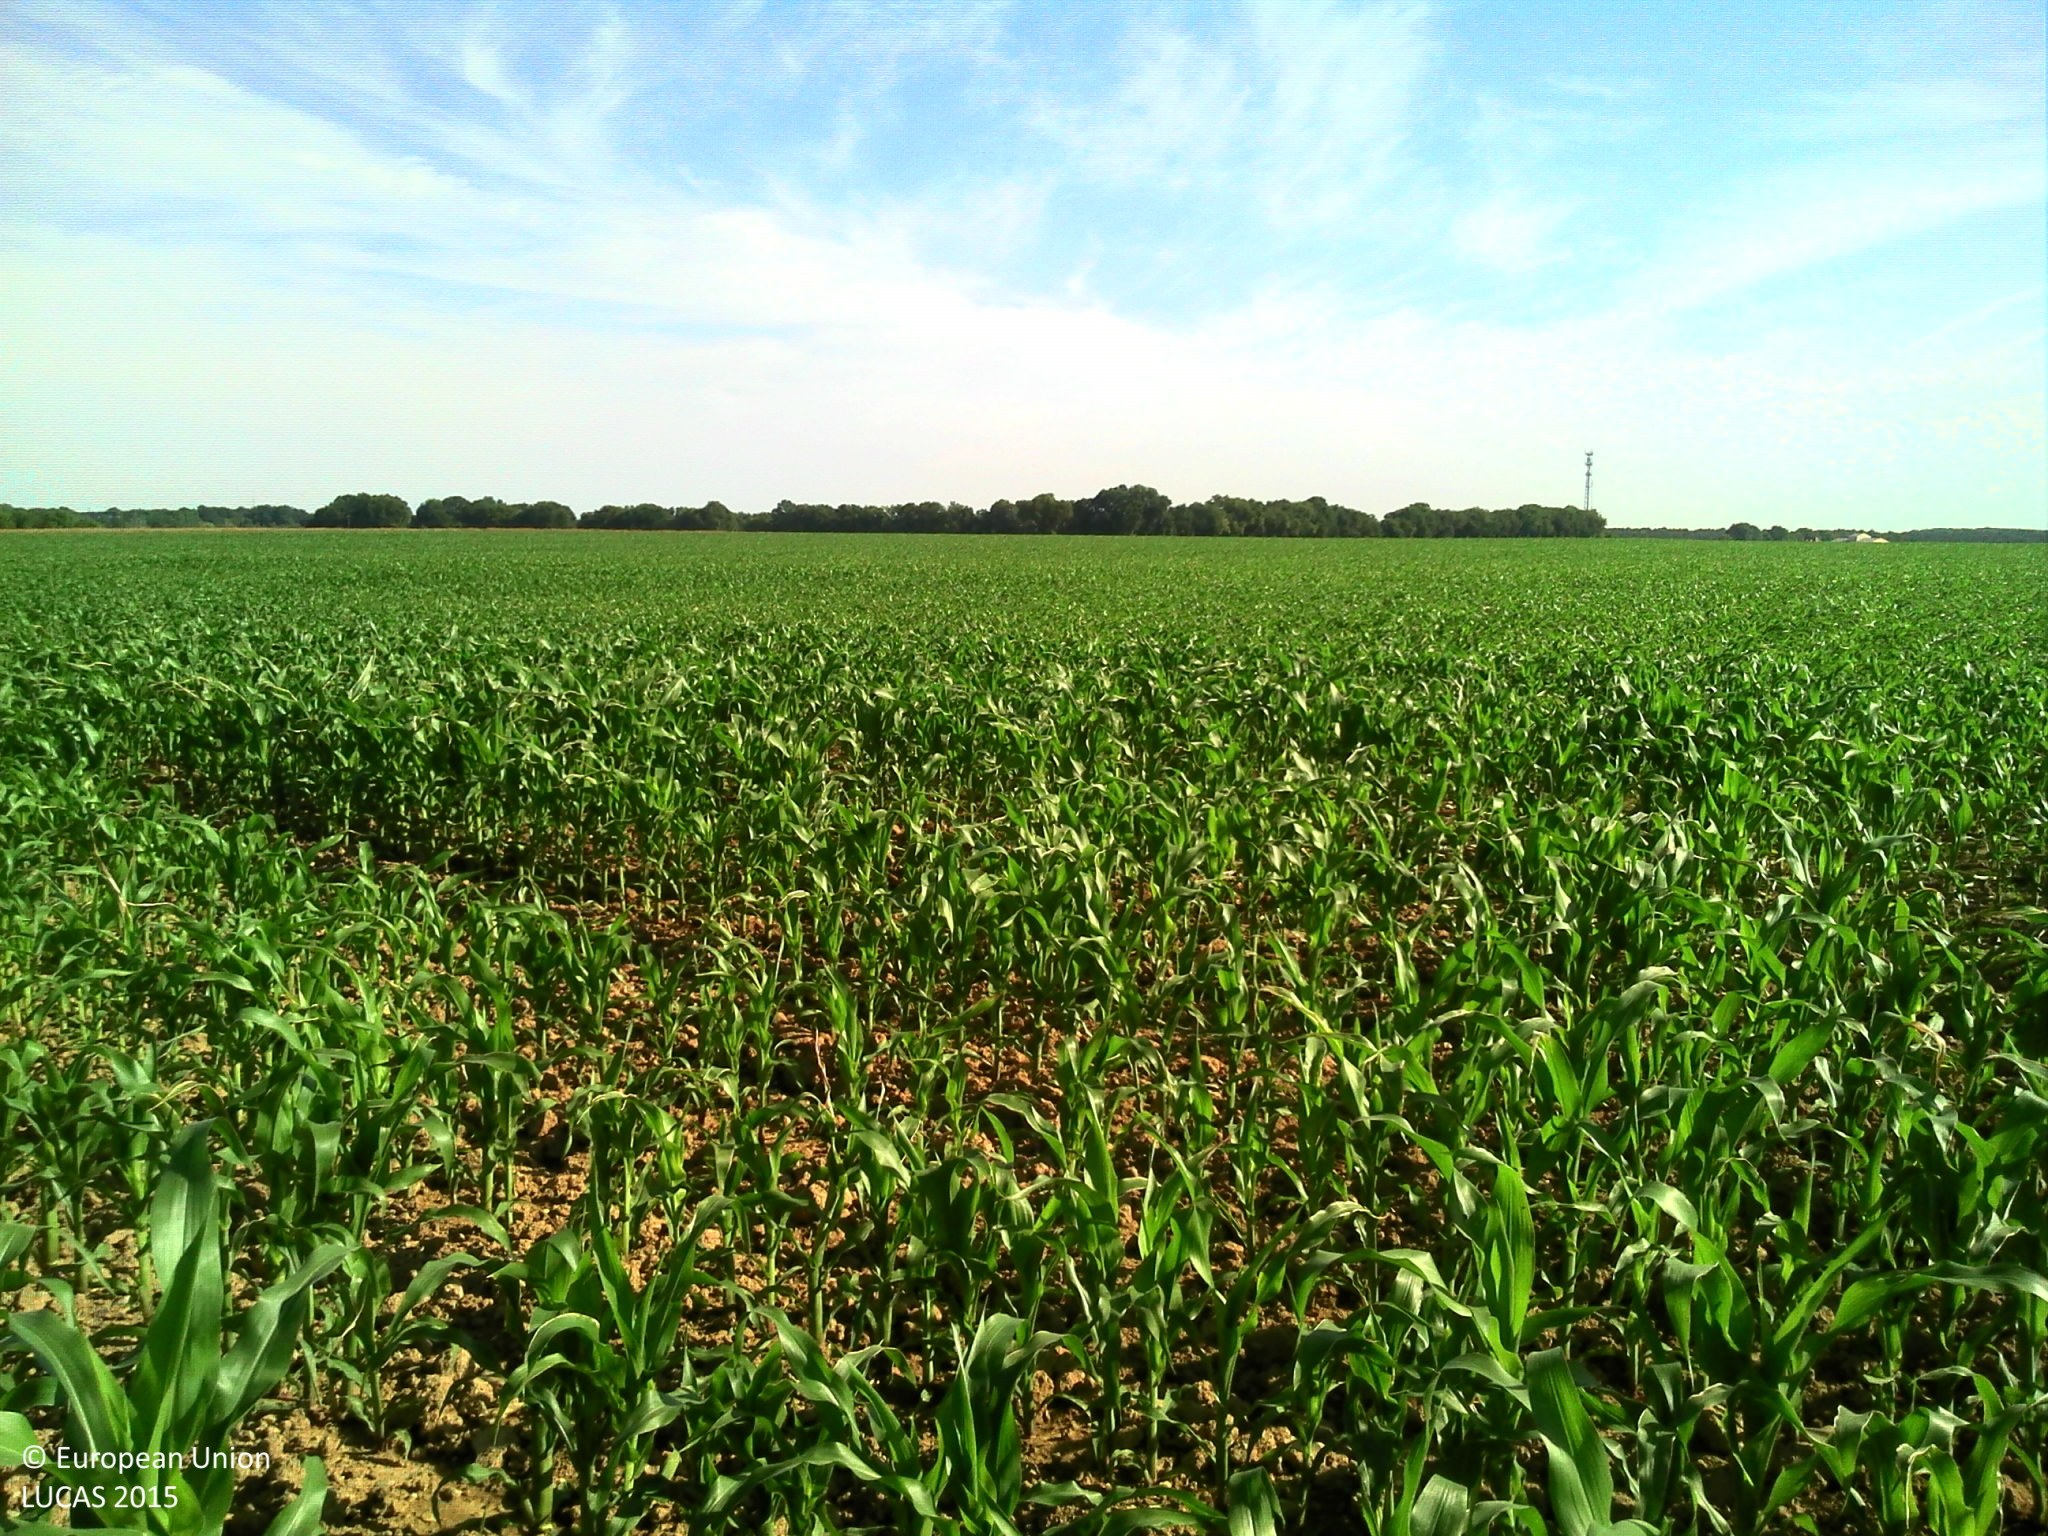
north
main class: Cropland
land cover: Maize
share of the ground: > 75 %
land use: Agriculture (excluding fallow land and kitchen gardens)
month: June
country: FR
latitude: 46.5029
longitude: 0.2463
